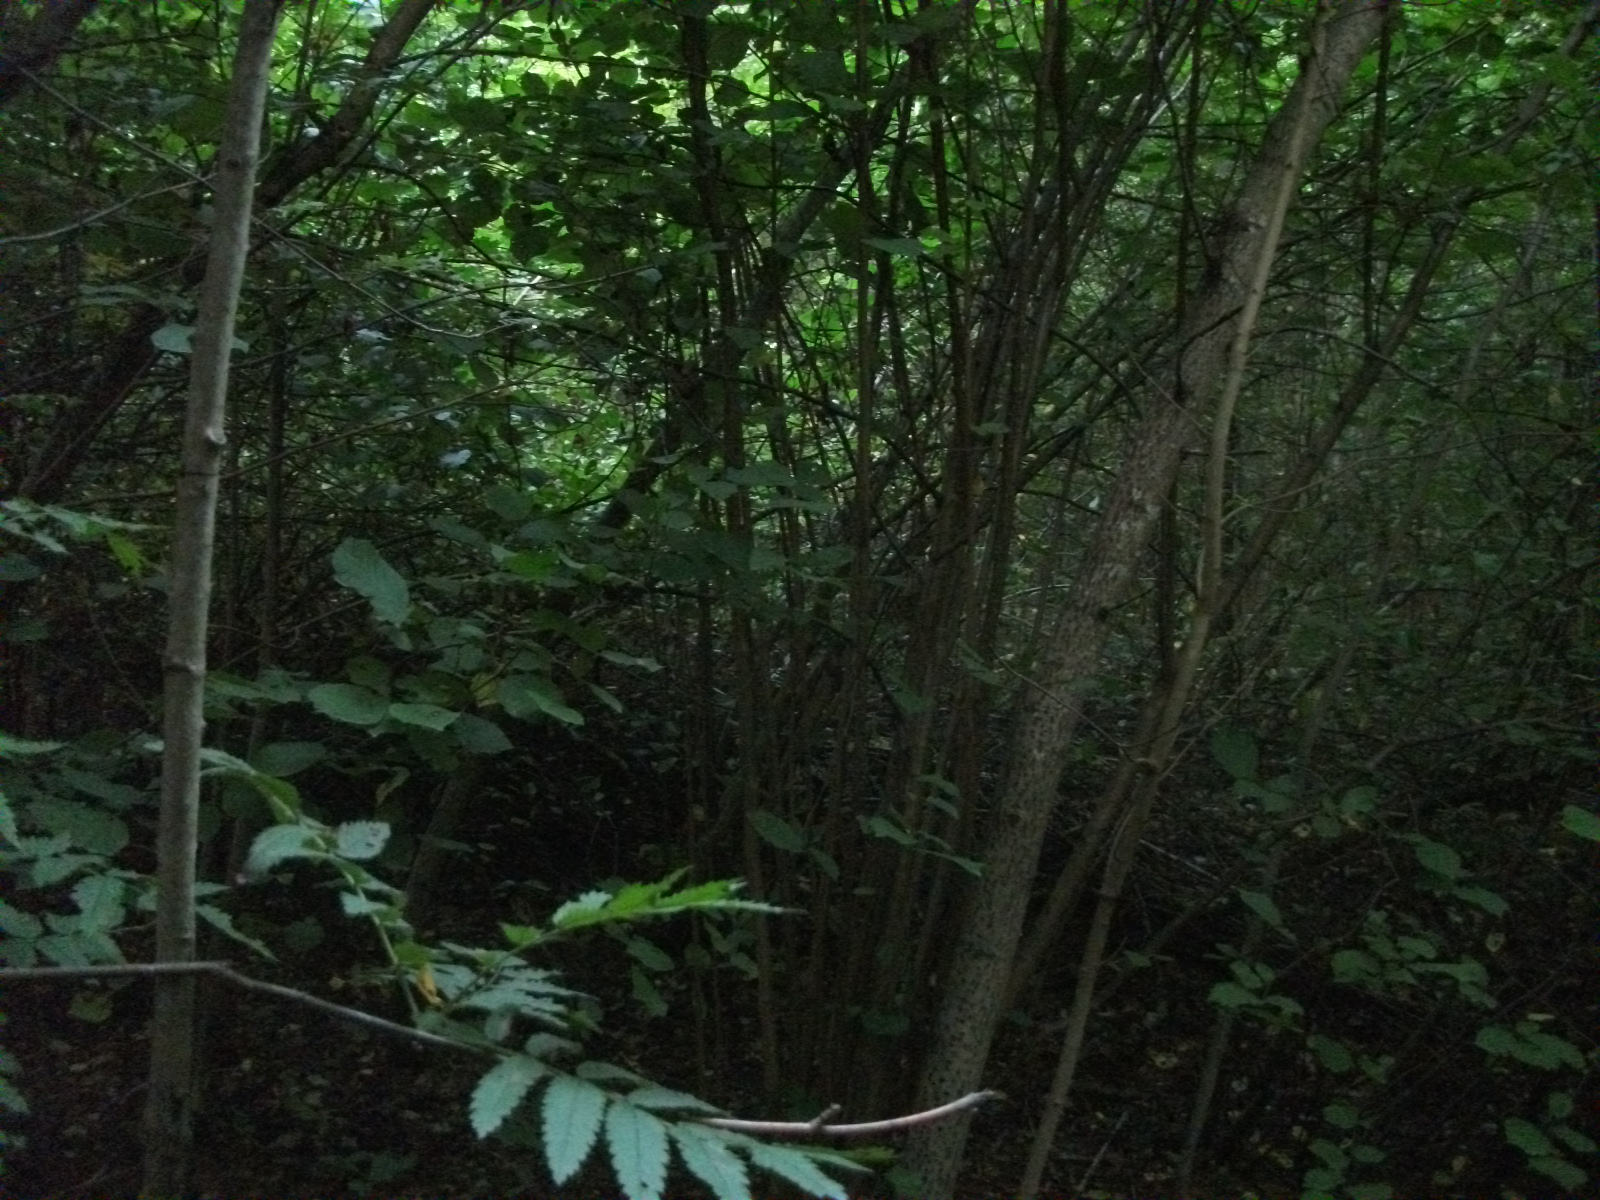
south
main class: Woodland
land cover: Broadleaved woodland
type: non-riverine alder, birch or aspen forest
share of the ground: > 75 %
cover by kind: broadleaved forest trees 90 %, shrubs 5 %, unconsolidated bare surface 5 %
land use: Forestry
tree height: > 5 m
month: August
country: LV
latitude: 56.7529
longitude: 26.4505
